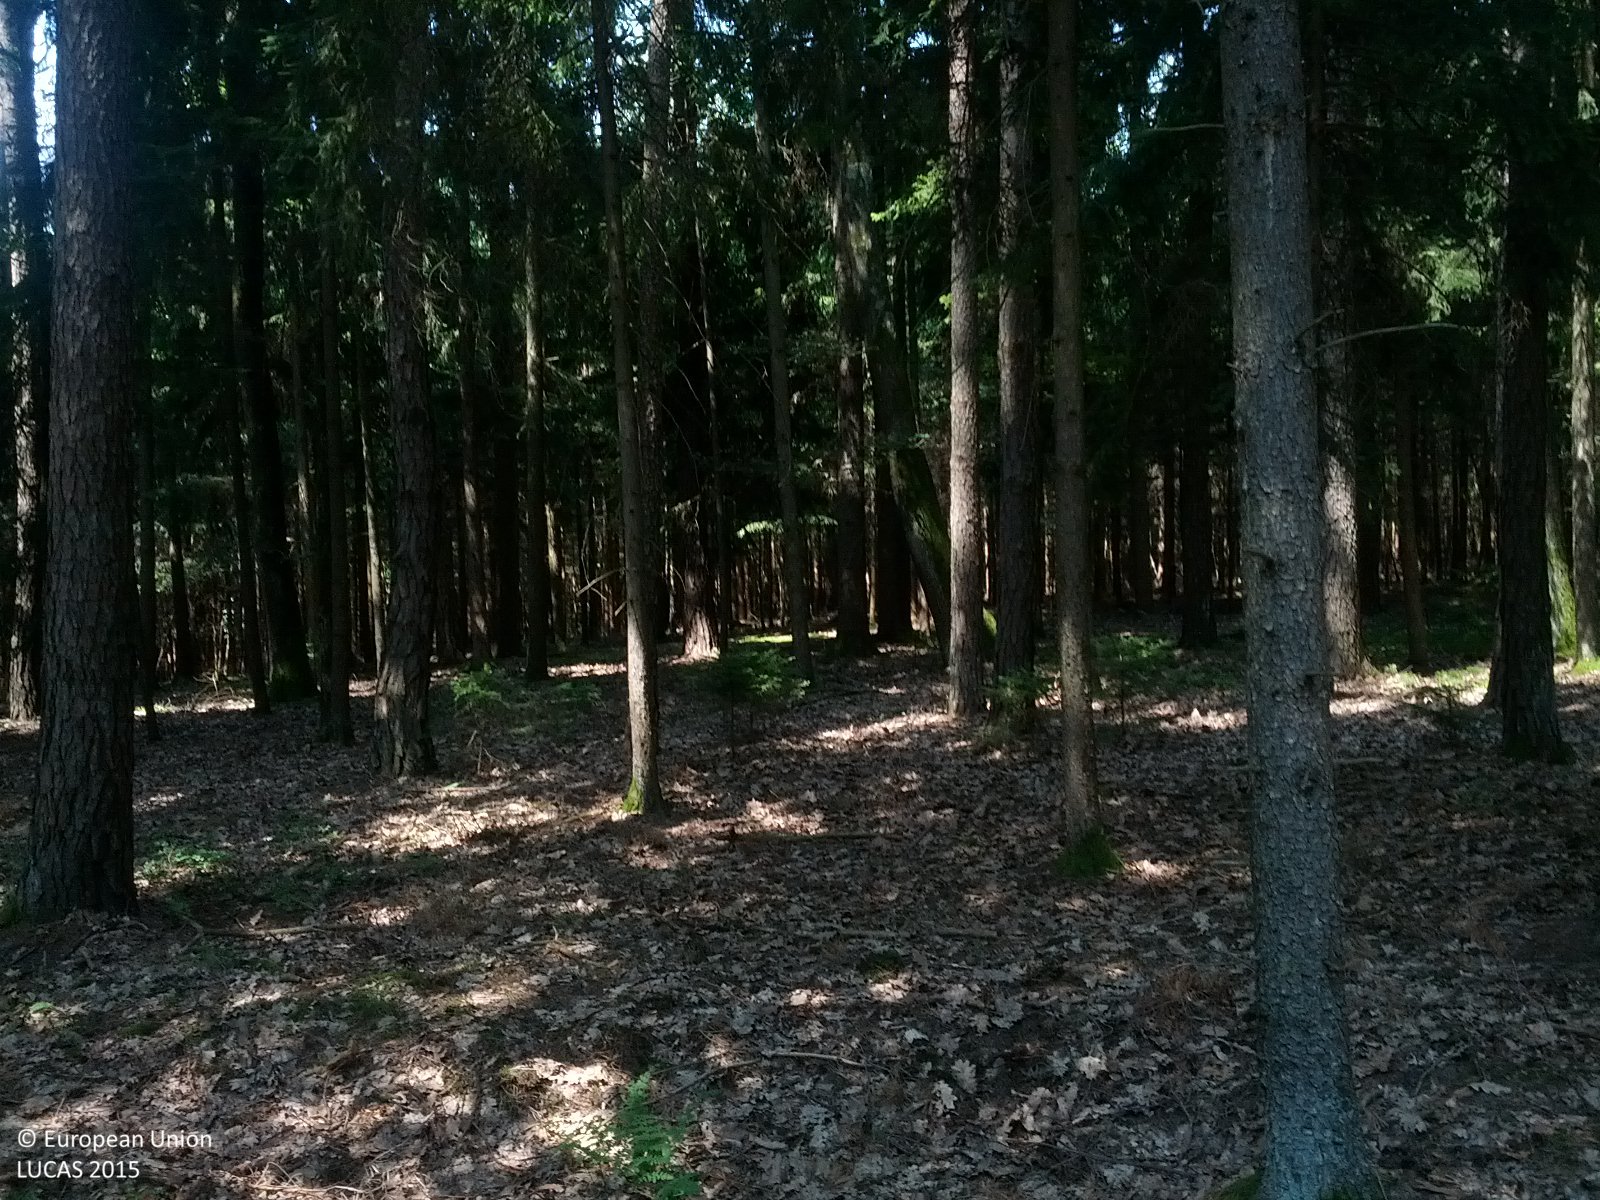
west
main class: Woodland
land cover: Pine dominated coniferous woodland
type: hemiboreal forest and nemoral coniferous forest and mixed broadleaved-coniferous forest
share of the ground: > 75 %
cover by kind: coniferous forest trees 90 %, broadleaved forest trees 5 %, herbaceous plants 5 %
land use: Forestry
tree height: > 5 m
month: July
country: AT
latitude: 47.2235
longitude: 16.1164
